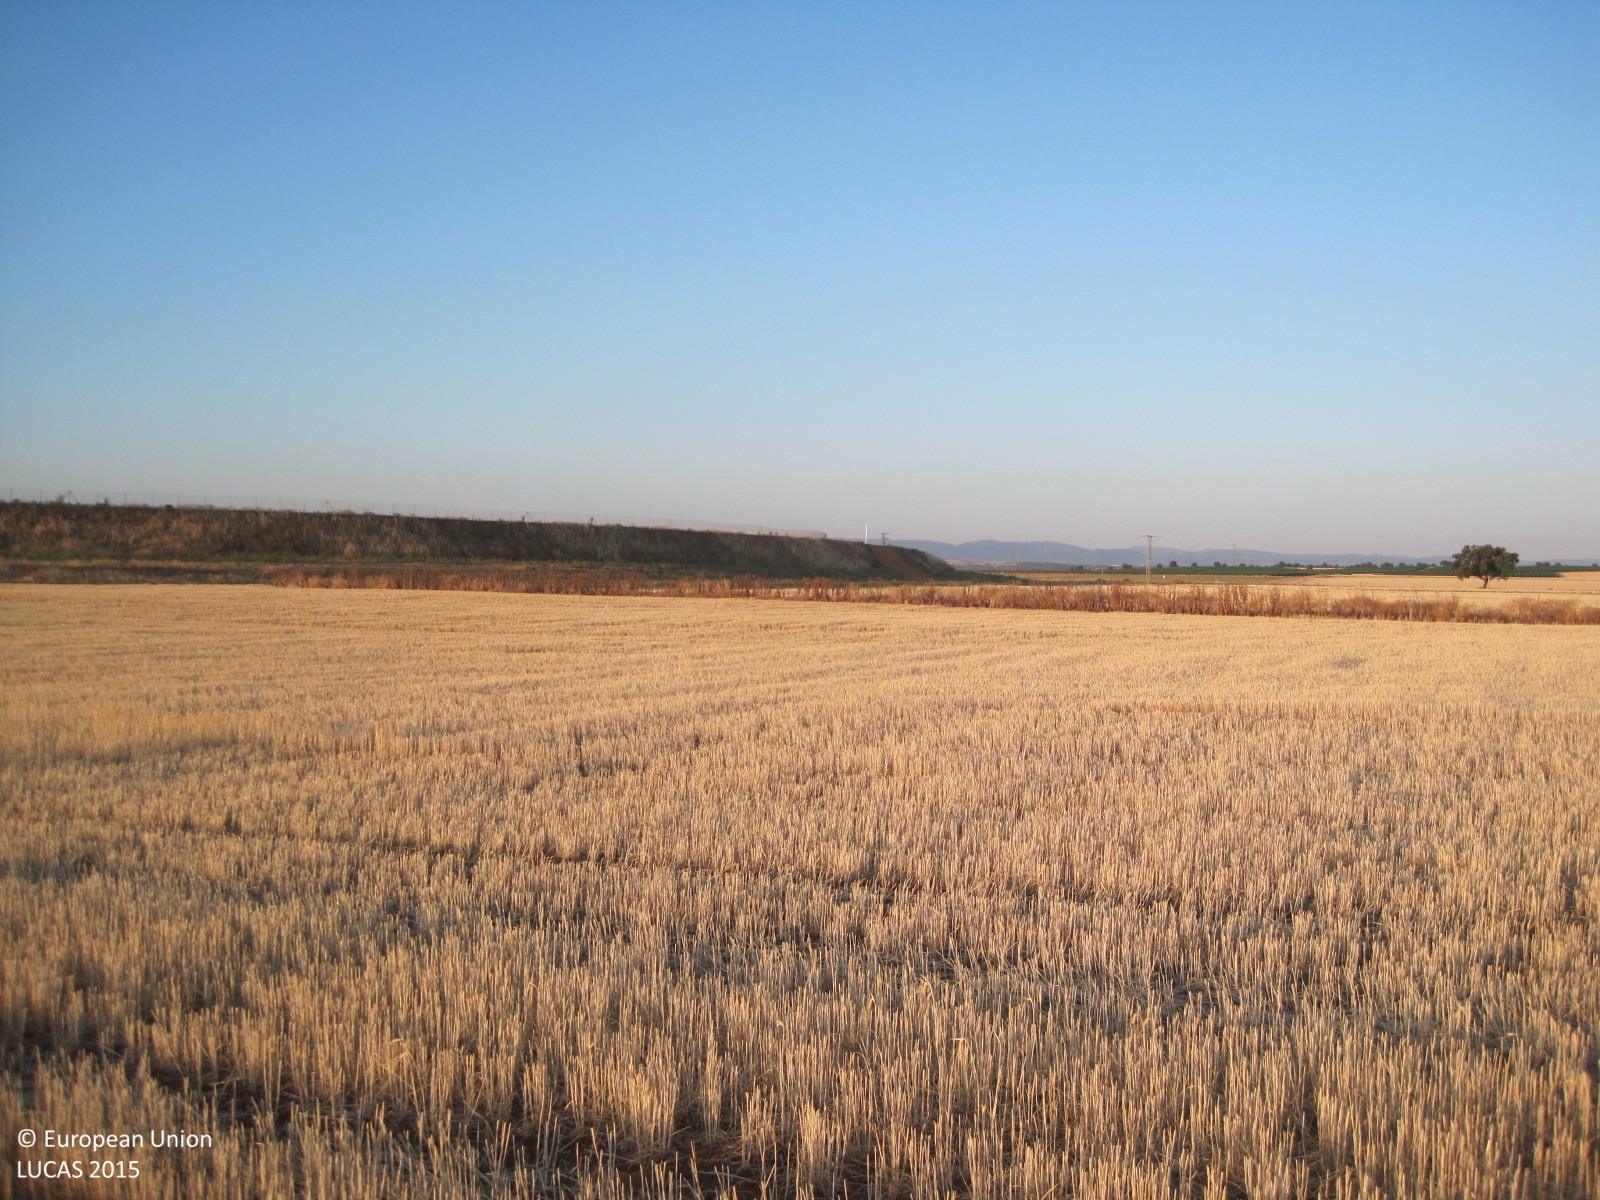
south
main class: Cropland
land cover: Barley
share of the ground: < 10 %
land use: Agriculture (excluding fallow land and kitchen gardens)
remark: Harvested field
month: June
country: ES
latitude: 39.8559
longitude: -4.6663
